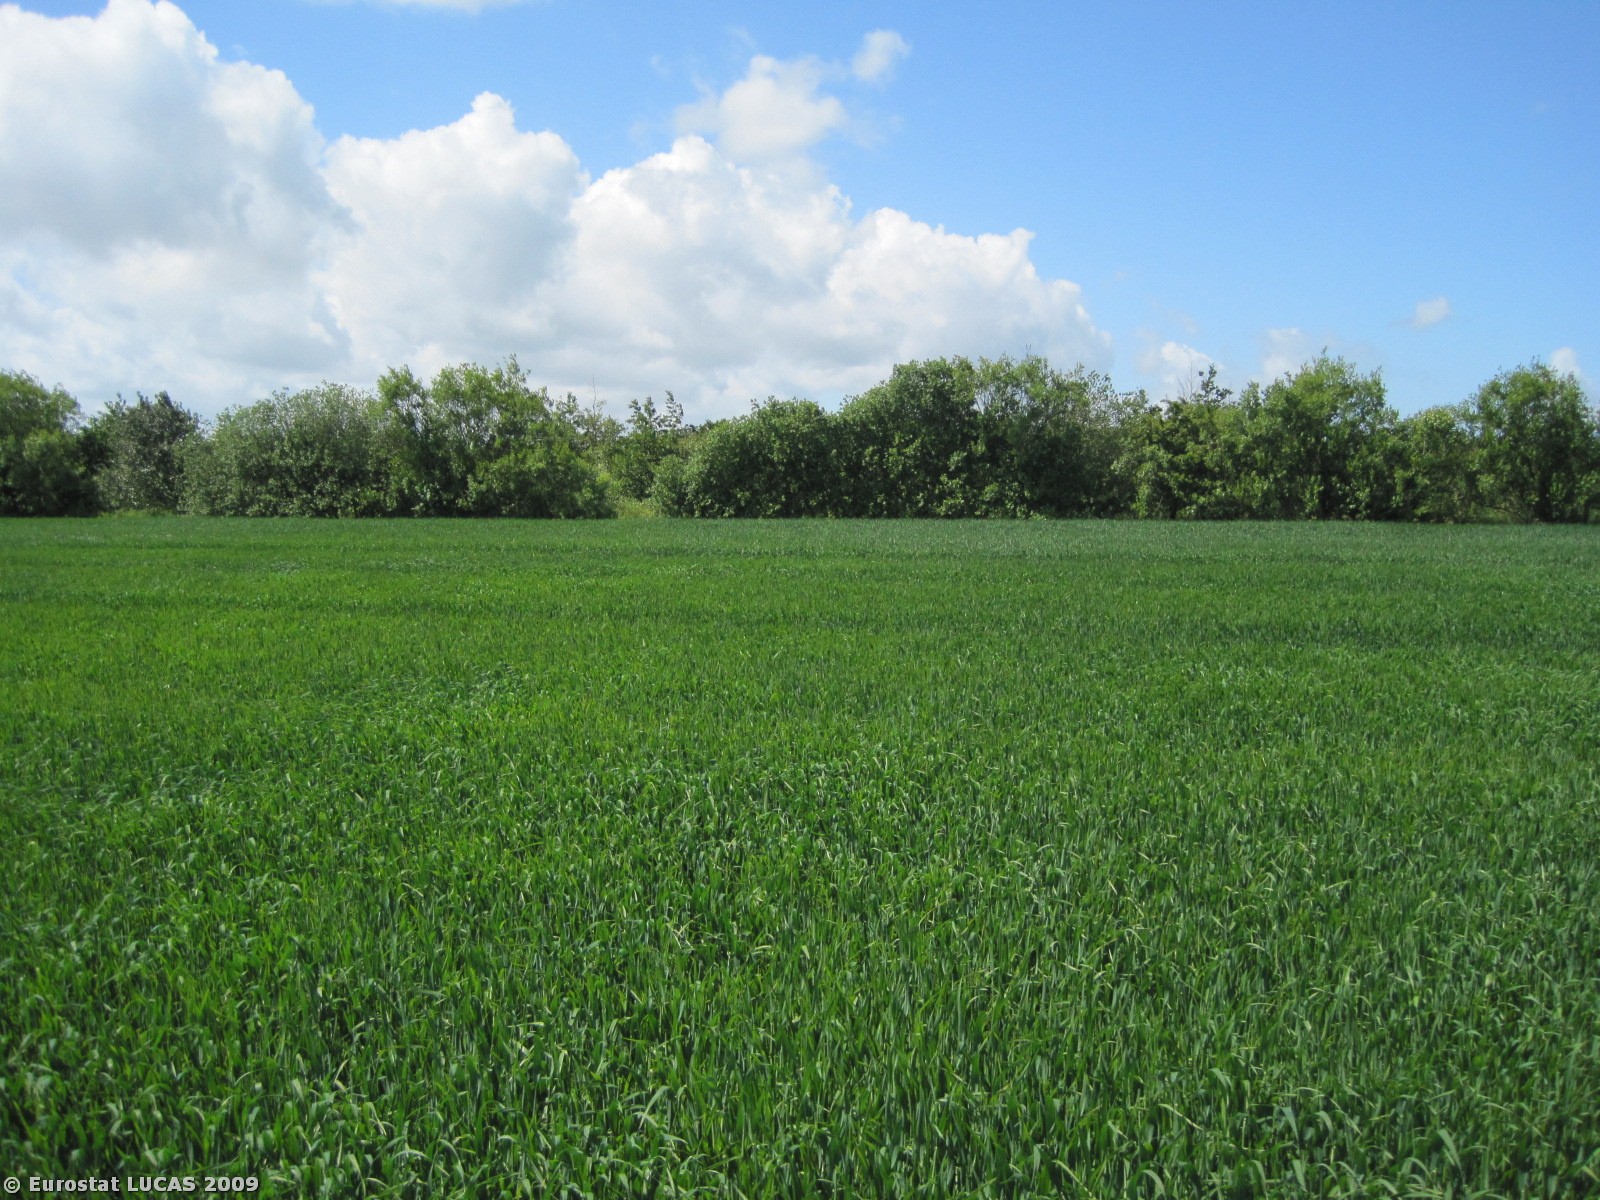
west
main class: Cropland
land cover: Oats
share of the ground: > 75 %
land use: Agriculture (excluding fallow land and kitchen gardens)
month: June
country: DK
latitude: 57.1225
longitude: 9.8846
